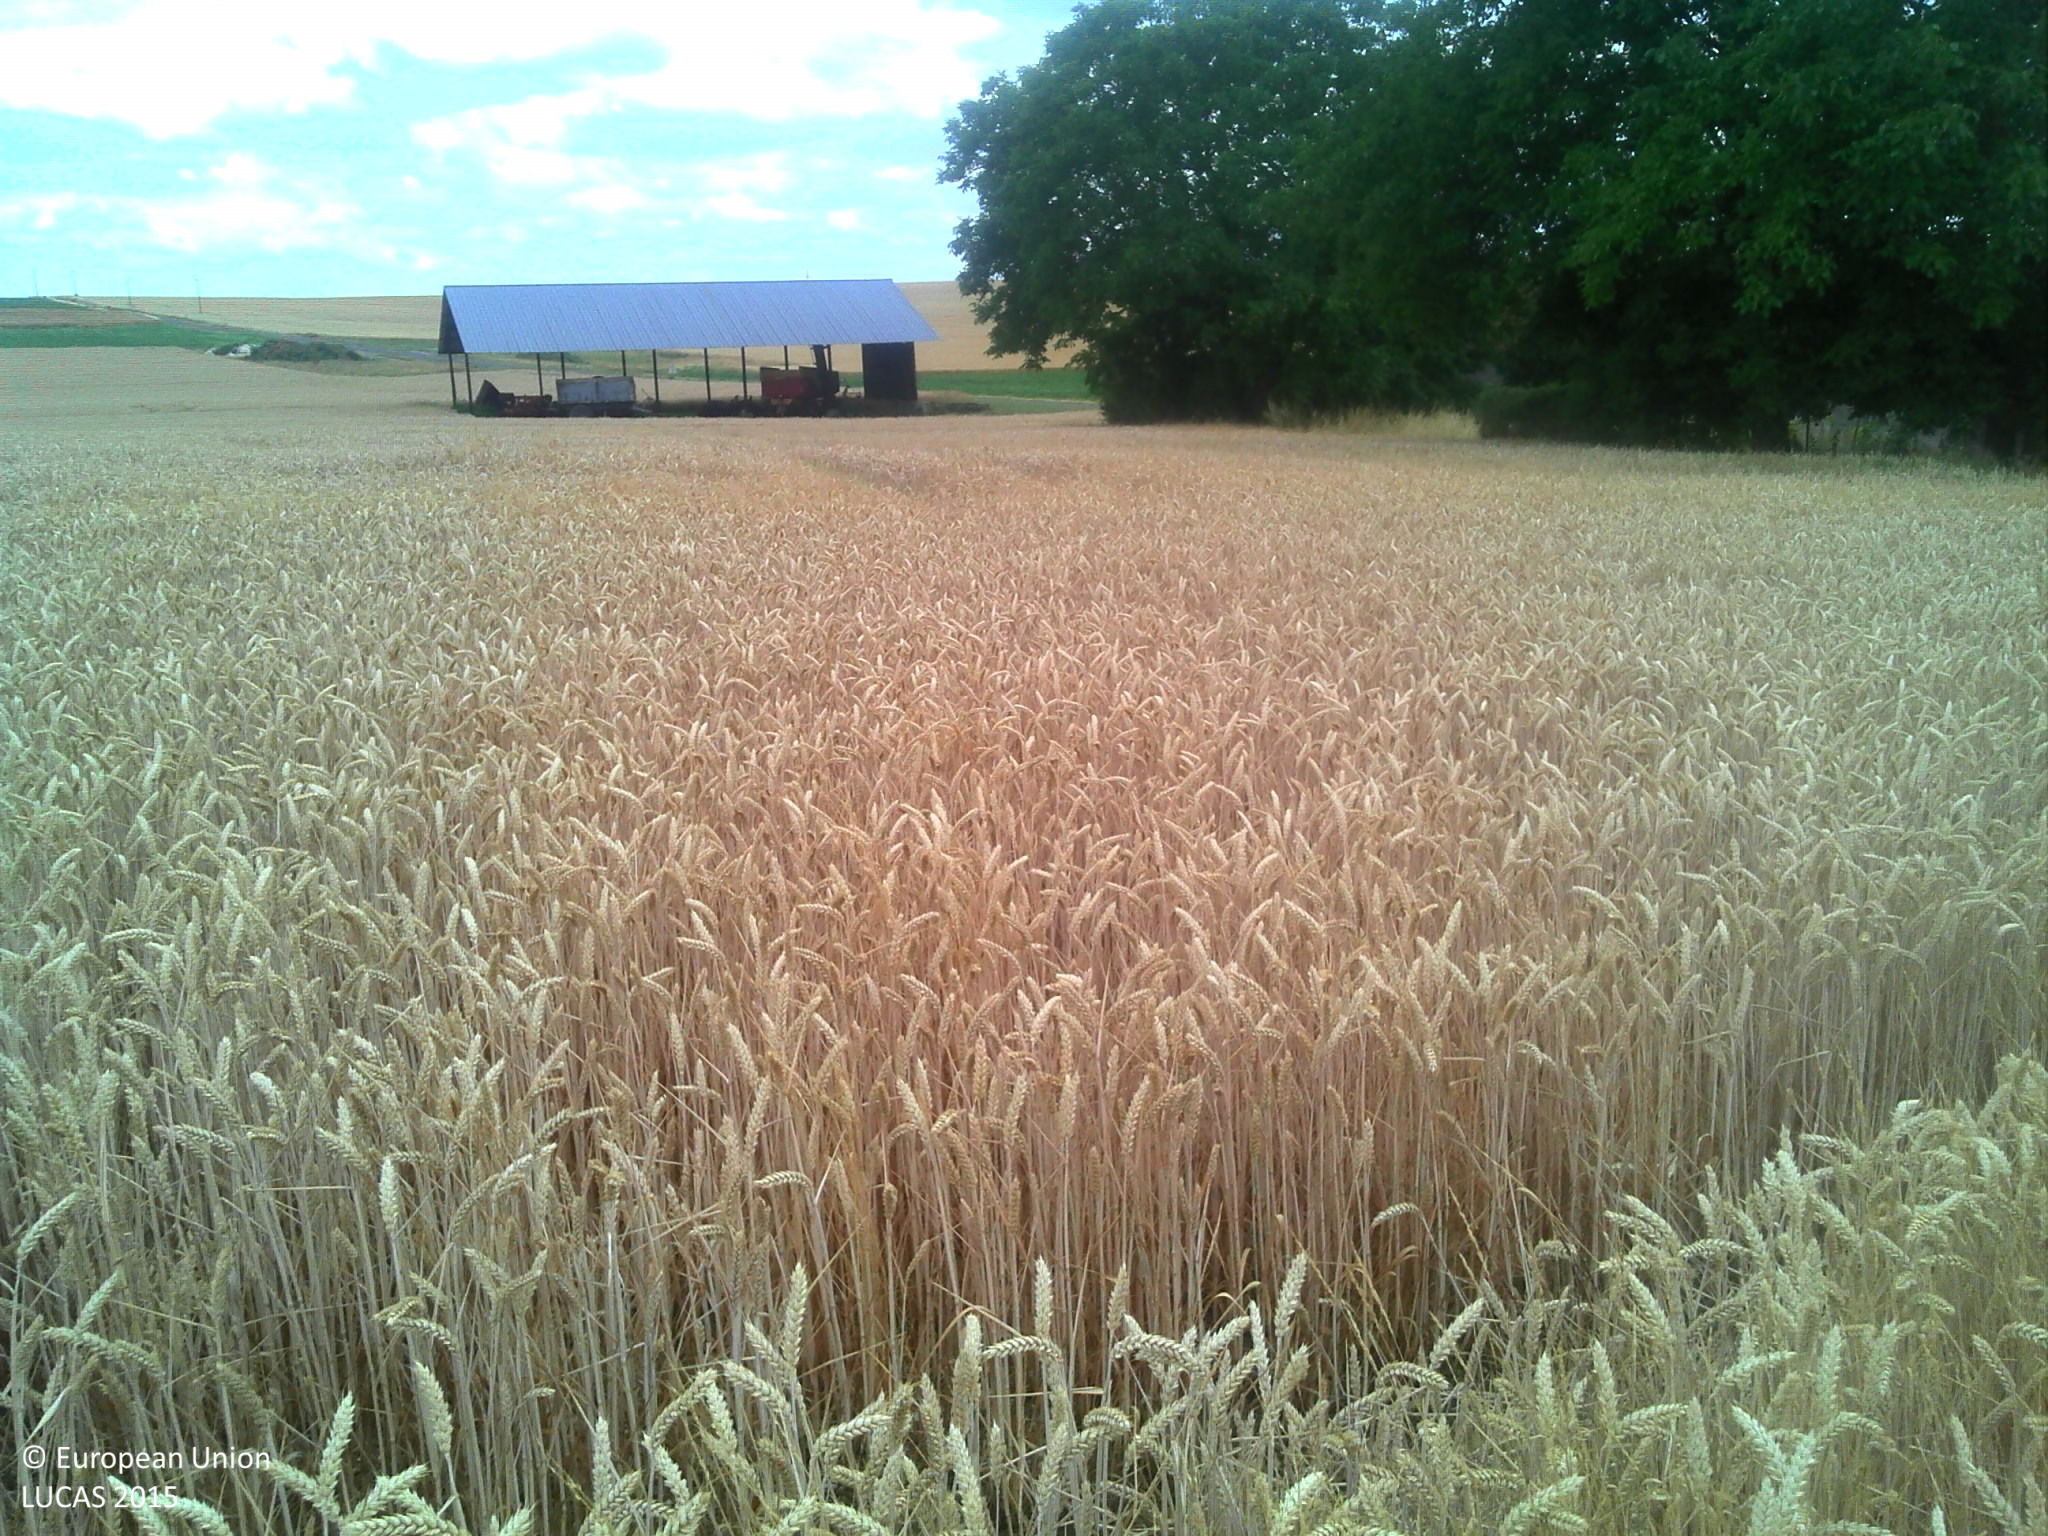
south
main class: Cropland
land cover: Common wheat
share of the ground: > 75 %
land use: Agriculture (excluding fallow land and kitchen gardens)
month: July
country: FR
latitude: 49.2311
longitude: 3.3320
